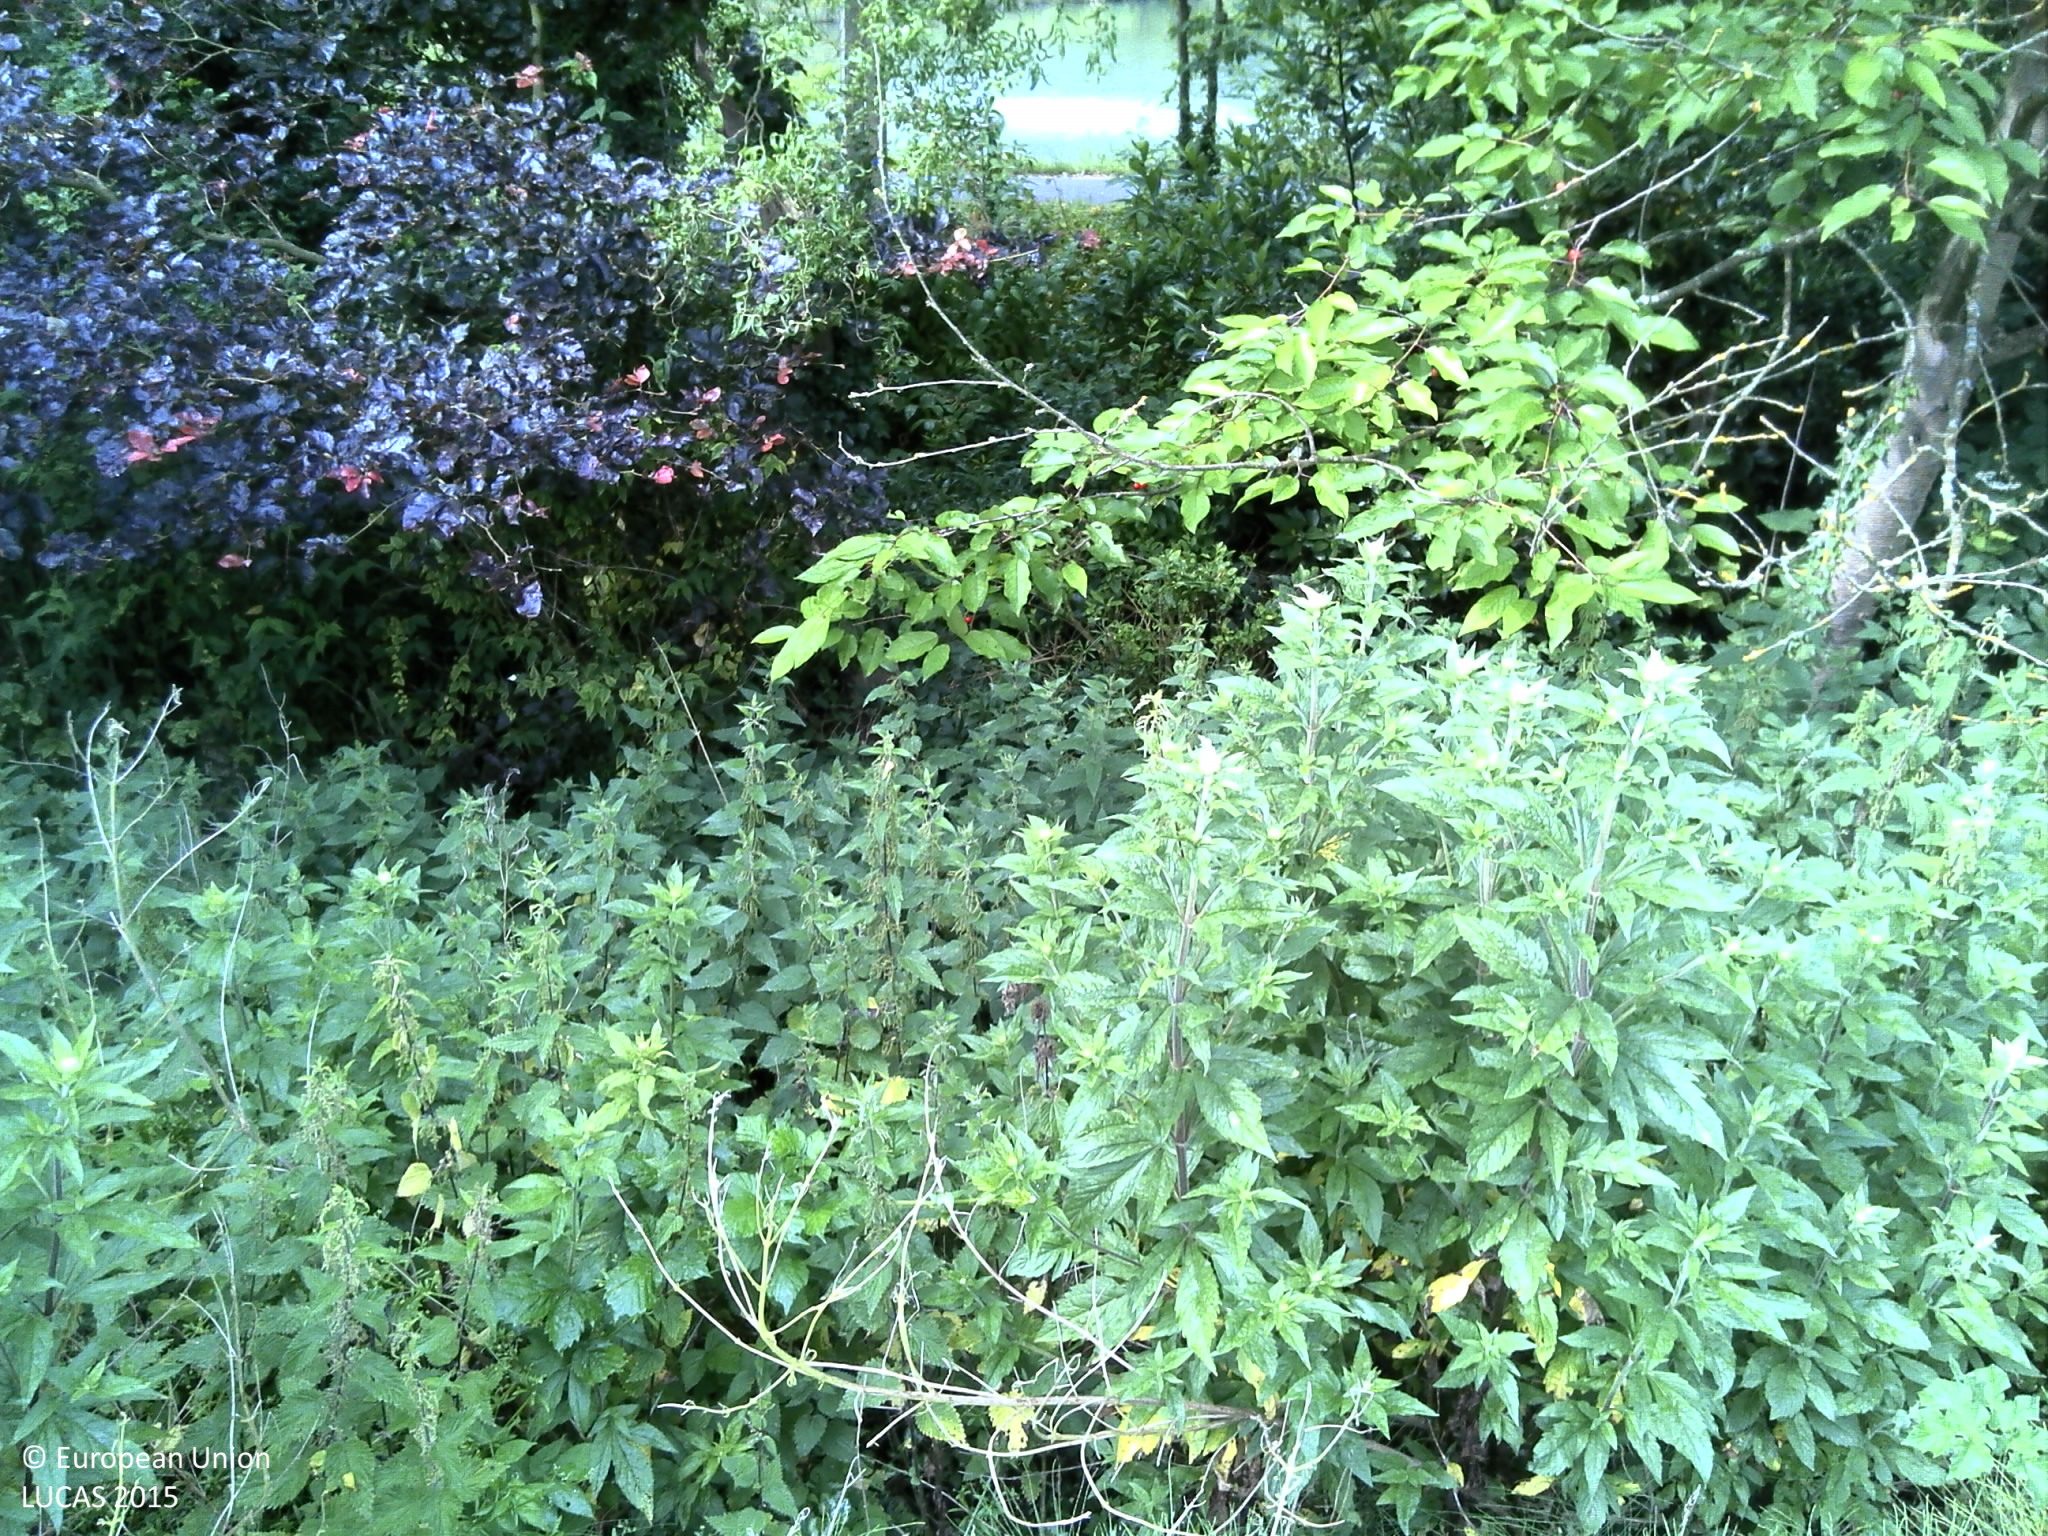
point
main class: Woodland
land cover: Broadleaved woodland
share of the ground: 50 - 75 %
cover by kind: broadleaved forest trees 100 %
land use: Semi-natural and natural areas not in use
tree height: < 5 m
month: July
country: FR
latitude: 49.8751
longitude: 1.1424
